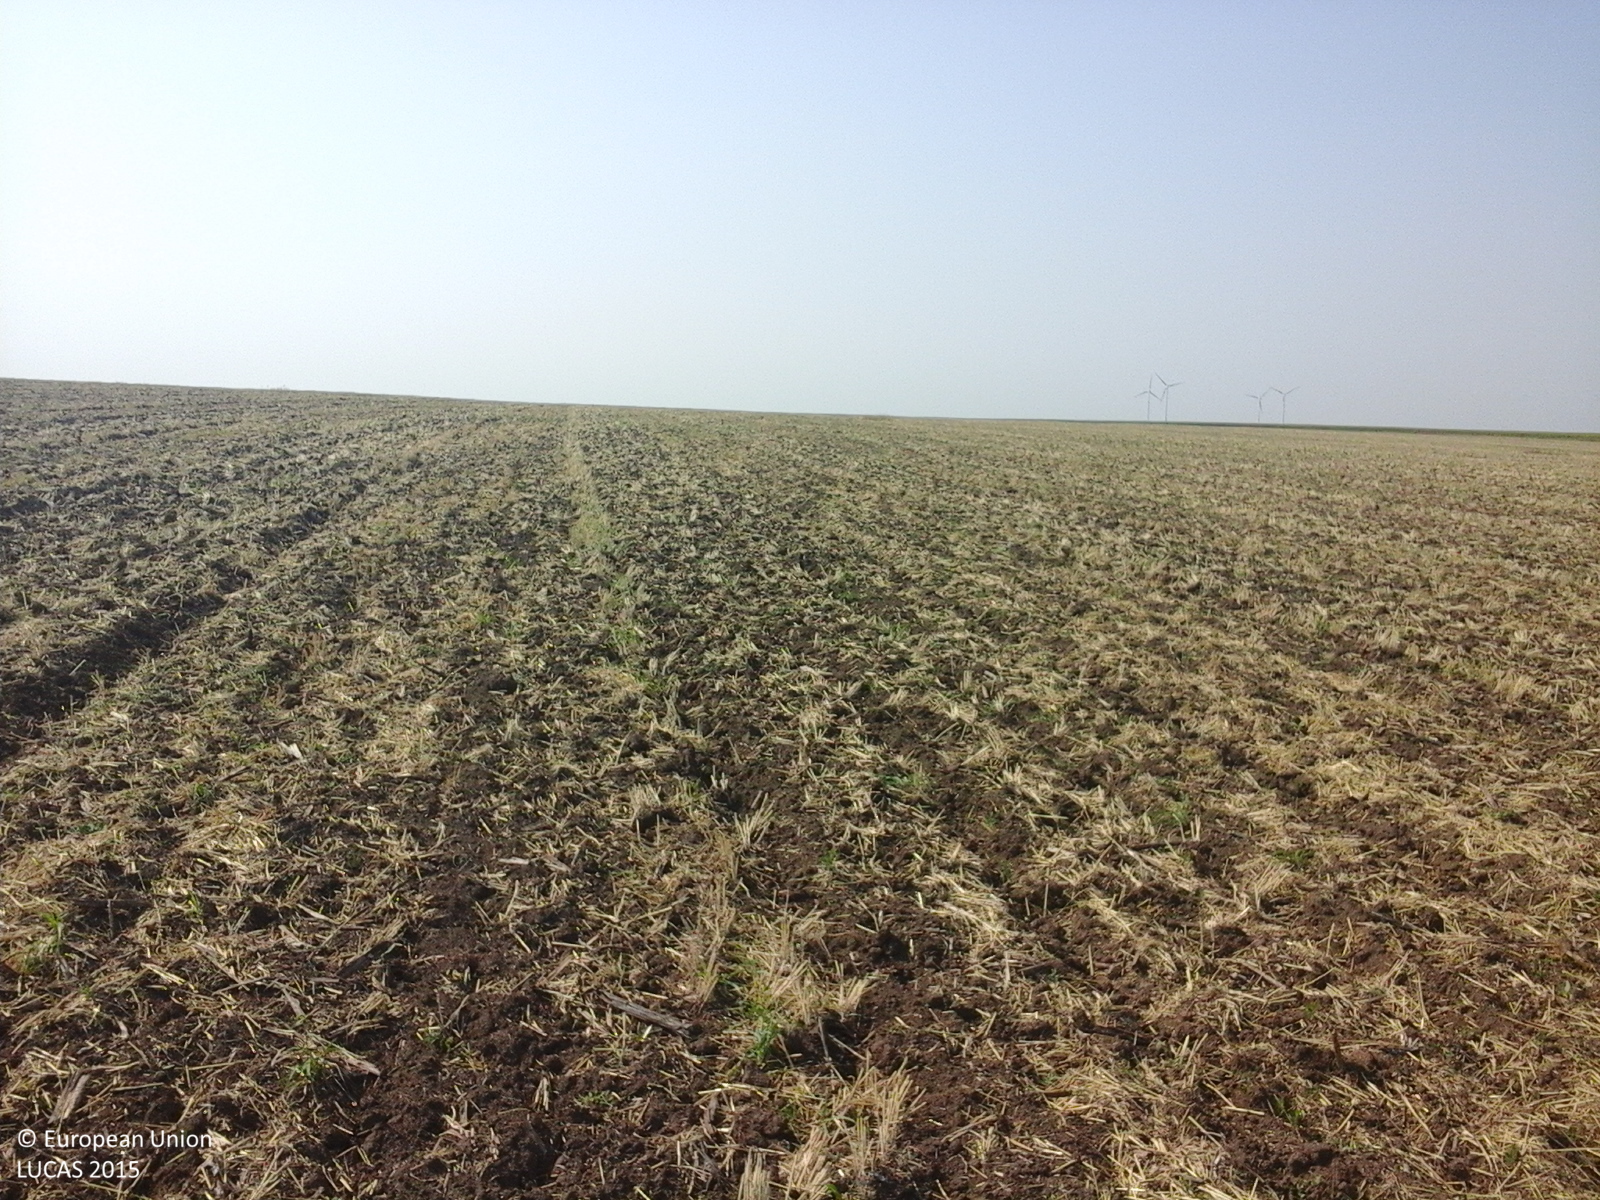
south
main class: Cropland
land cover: Common wheat
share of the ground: 25 - 50 %
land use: Agriculture (excluding fallow land and kitchen gardens)
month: July
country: RO
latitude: 45.5693
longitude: 27.8605
